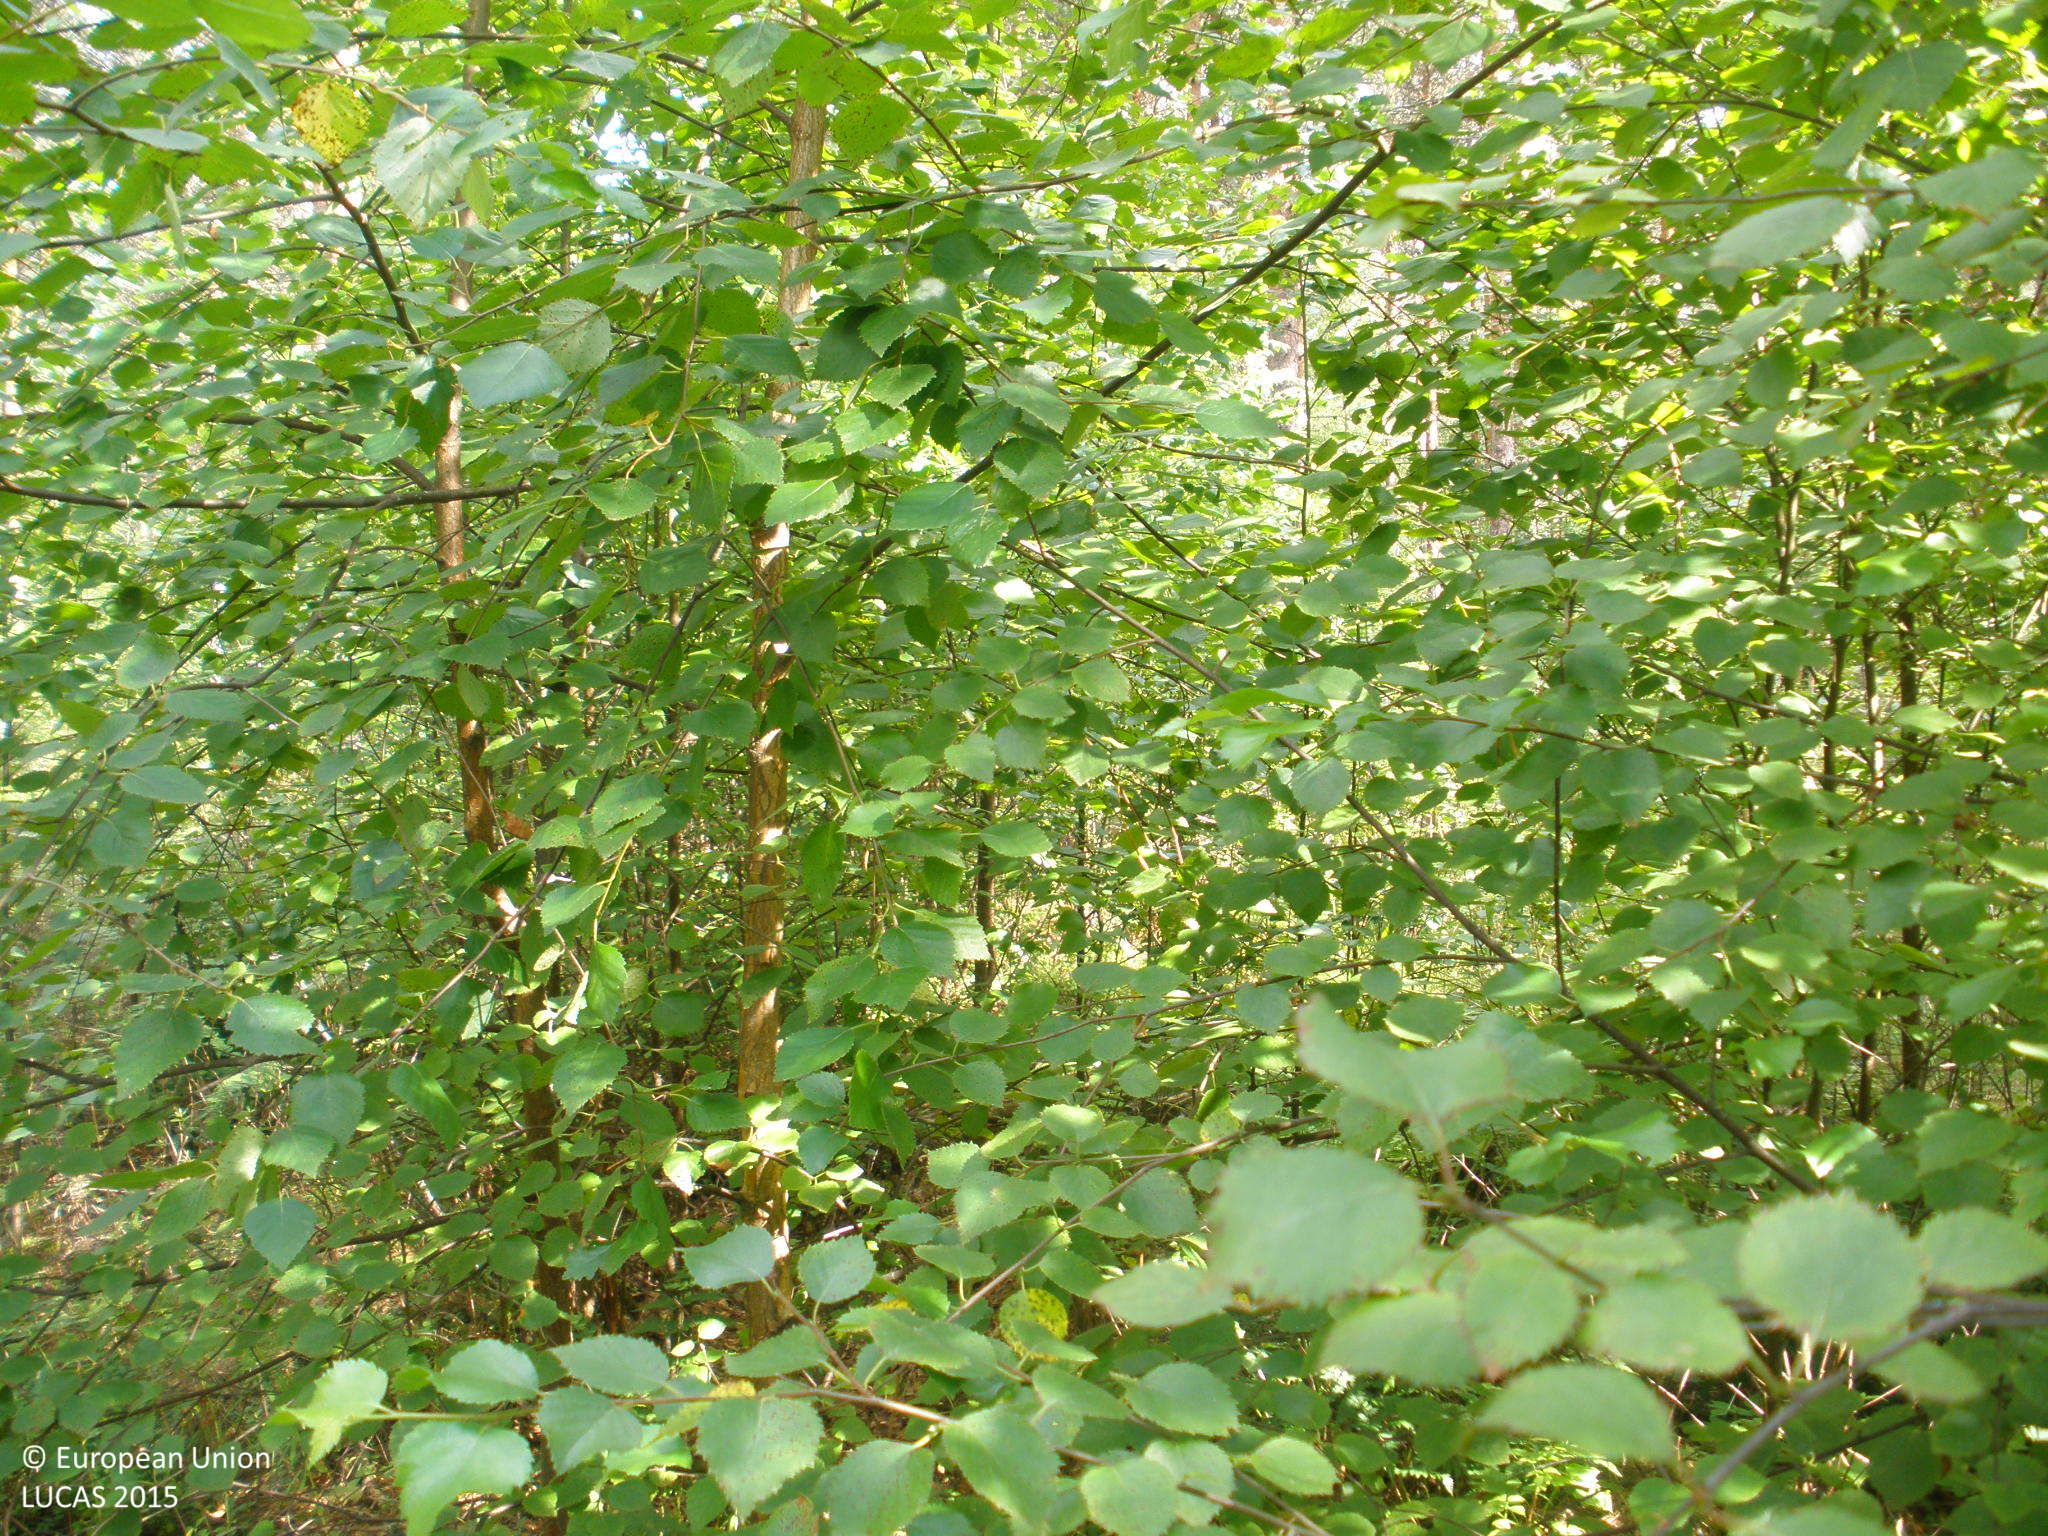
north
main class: Woodland
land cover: Pine dominated mixed woodland
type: boreal forest
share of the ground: > 75 %
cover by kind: coniferous forest trees 60 %, broadleaved forest trees 25 %, lichens and mosses 10 %, herbaceous plants 5 %
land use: Forestry
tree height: > 5 m
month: July
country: FI
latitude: 61.1868
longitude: 25.0490
